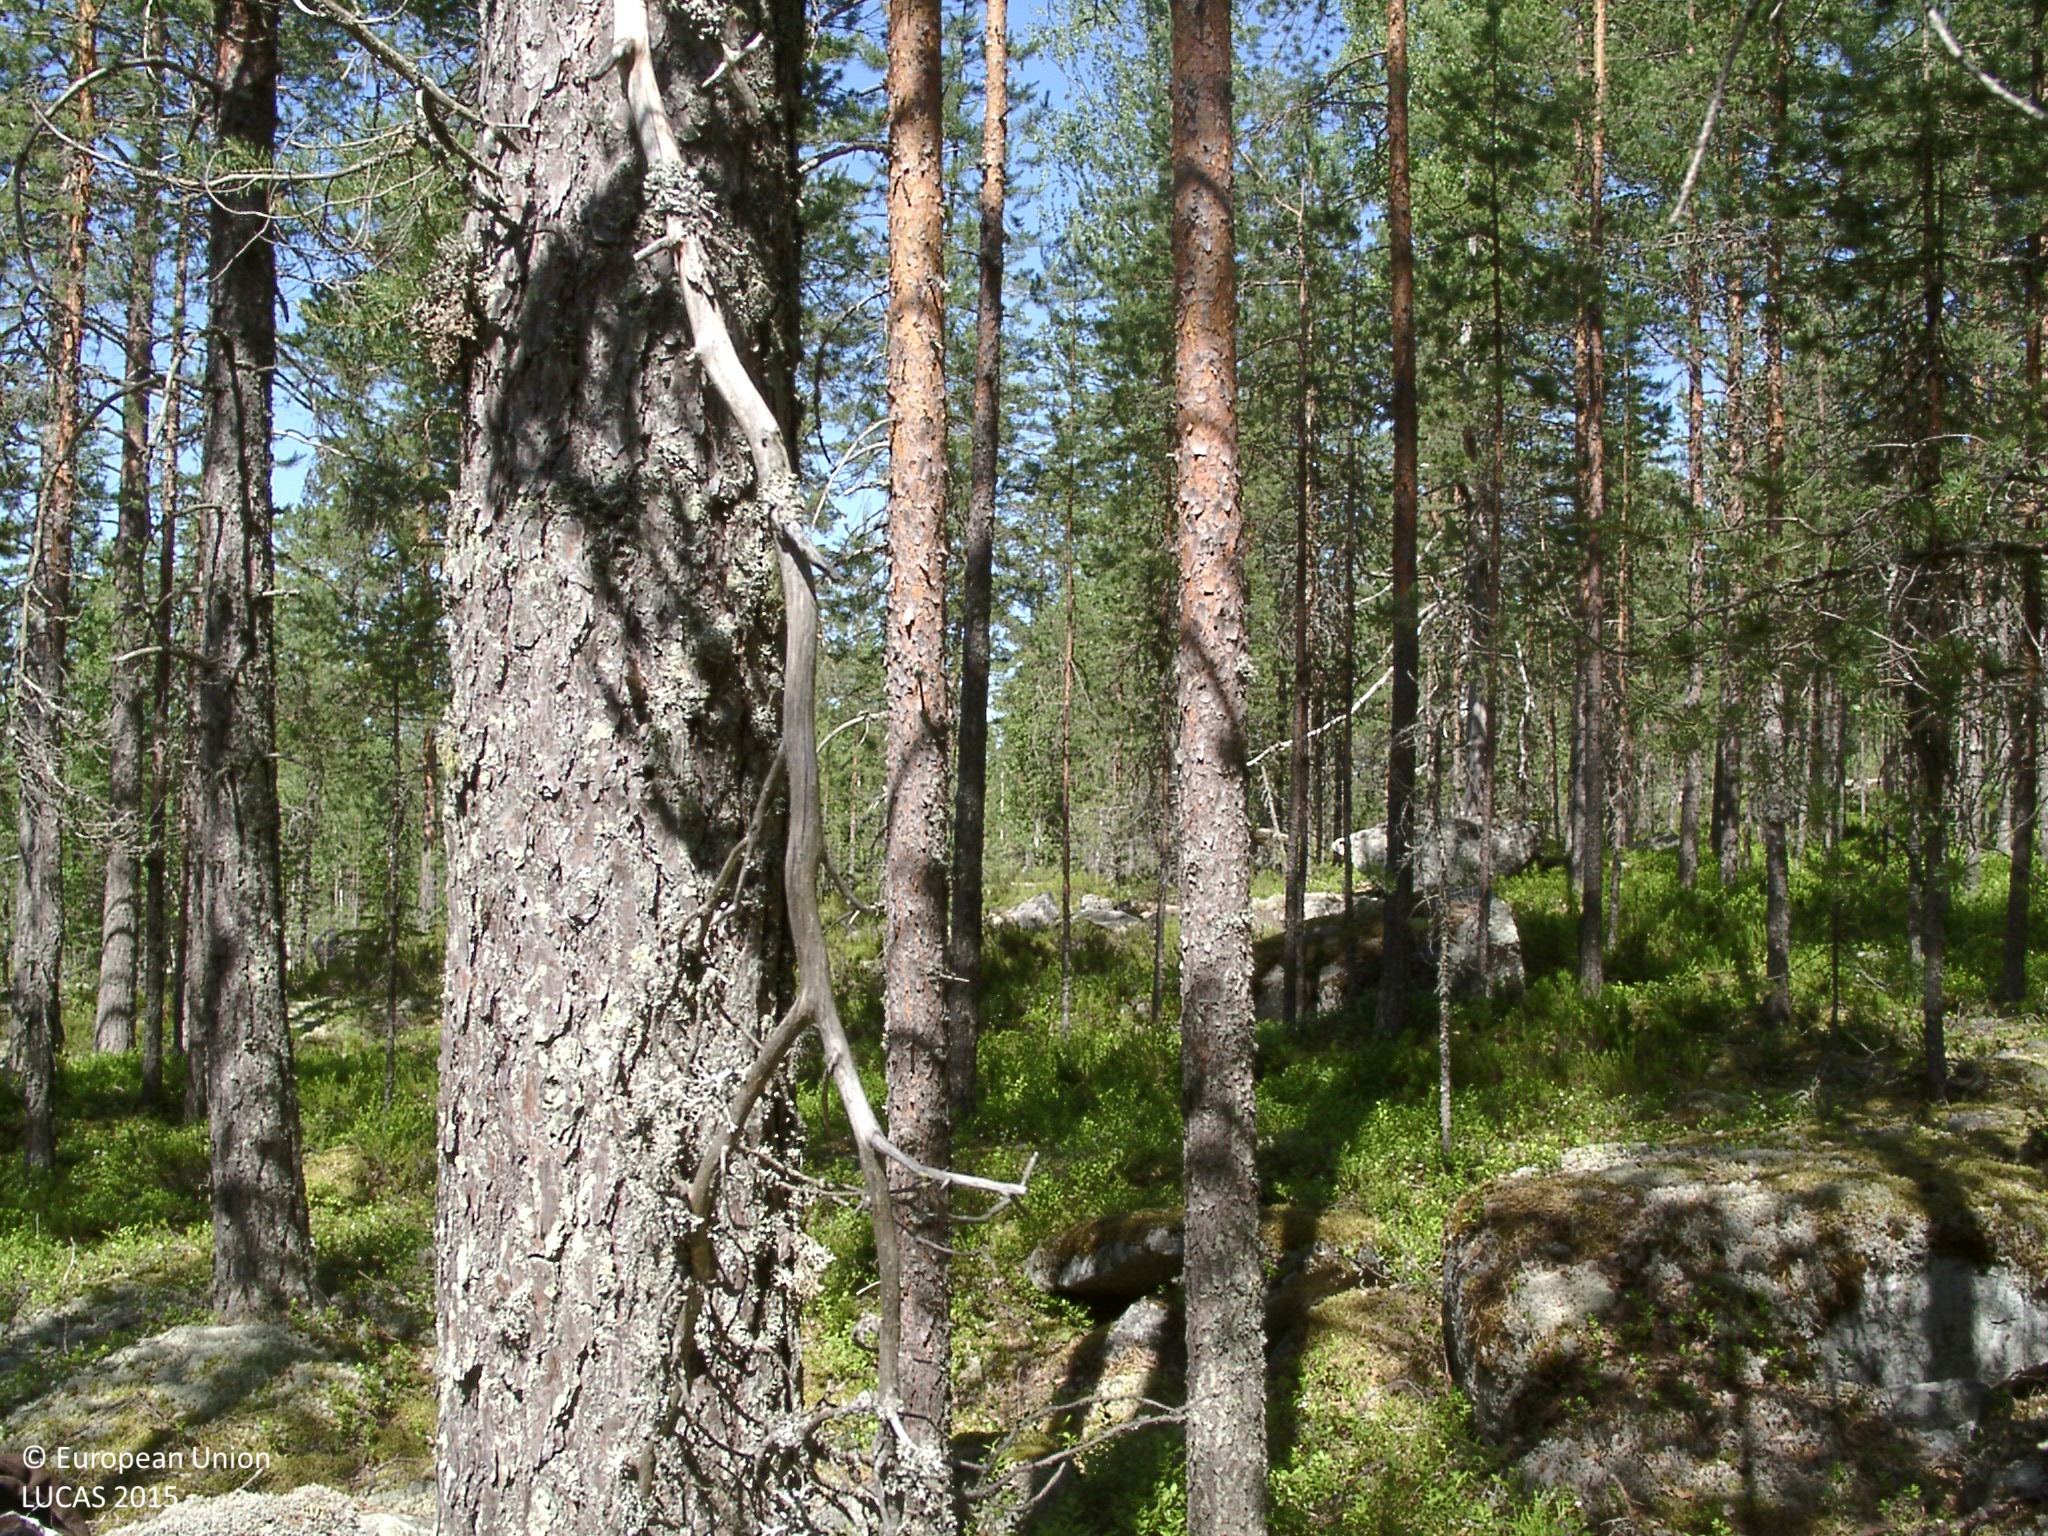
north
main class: Woodland
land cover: Pine dominated coniferous woodland
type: boreal forest
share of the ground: 50 - 75 %
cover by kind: coniferous forest trees 50 %, shrubs 30 %, lichens and mosses 10 %, broadleaved forest trees 5 %, consolidated bare surface 5 %
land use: Semi-natural and natural areas not in use
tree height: > 5 m
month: July
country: FI
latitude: 61.9808
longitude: 25.5553
